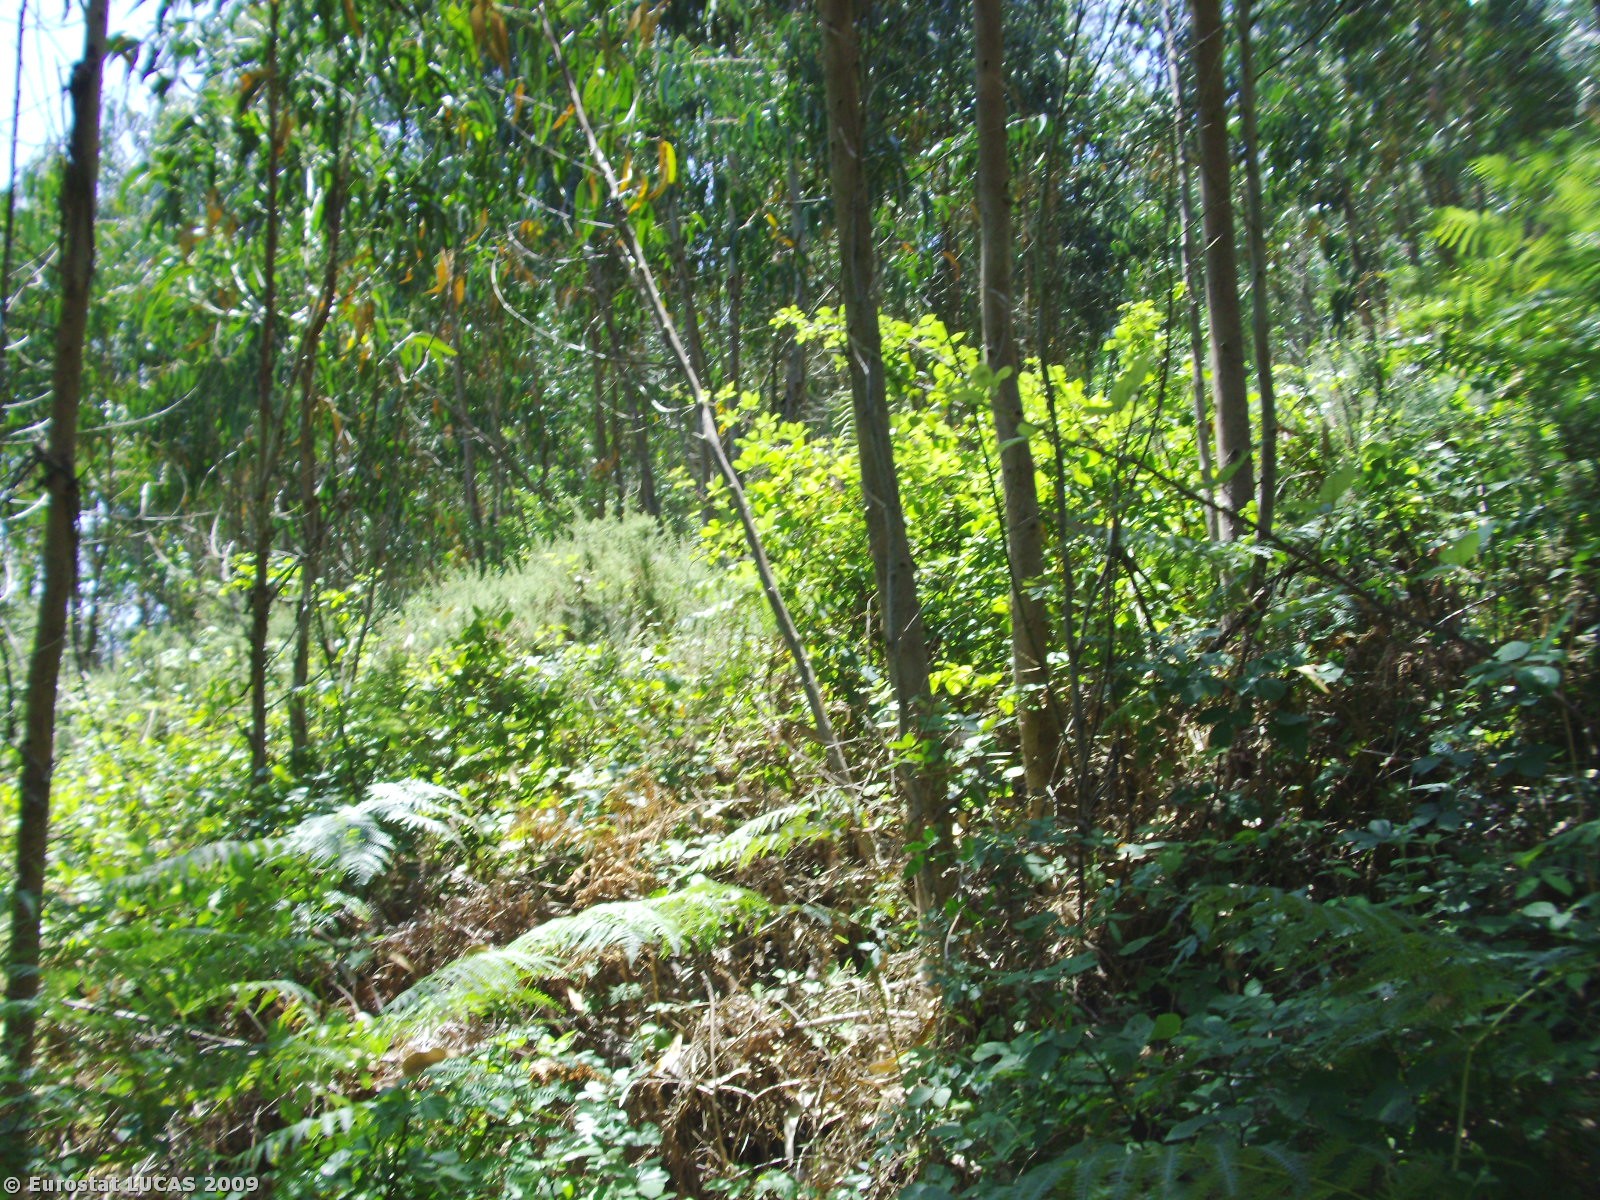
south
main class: Shrubland
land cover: Shrubland with sparse tree cover
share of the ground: > 75 %
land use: Unused
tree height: > 5 m
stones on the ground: 10 - 25 %
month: July
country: PT
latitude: 38.9524
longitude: -9.2494
